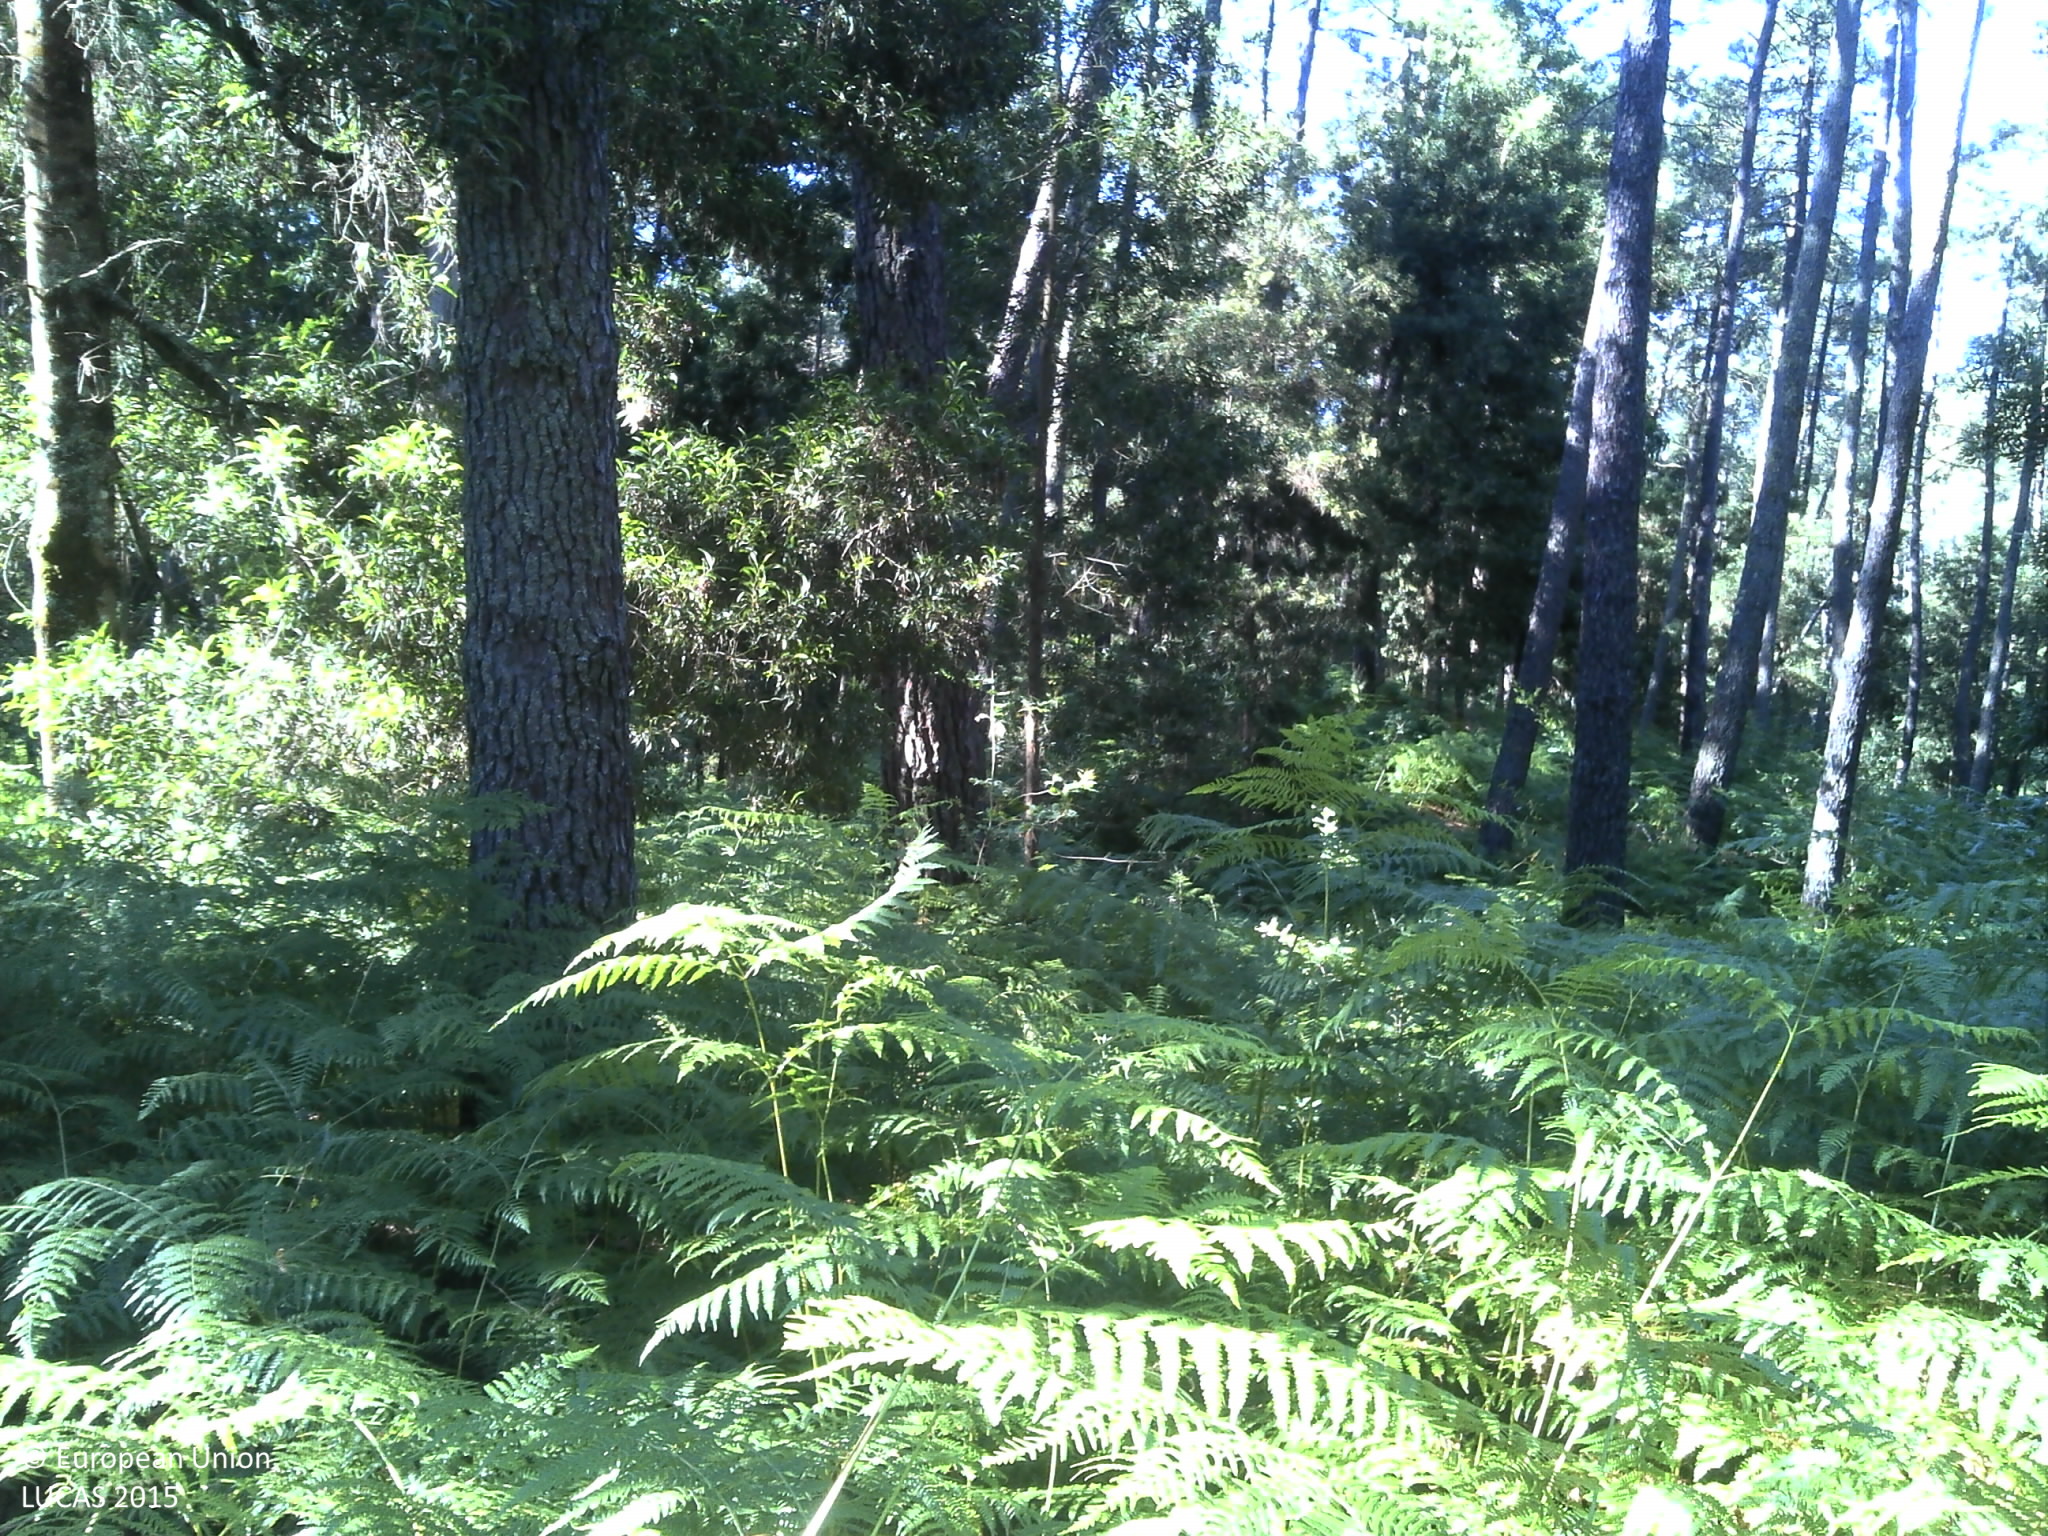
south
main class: Woodland
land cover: Pine dominated coniferous woodland
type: coniferous forest of the mediterranean region
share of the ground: 50 - 75 %
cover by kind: coniferous forest trees 60 %, shrubs 25 %, unconsolidated bare surface 10 %, herbaceous plants 5 %
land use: Forestry
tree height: > 5 m
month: June
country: PT
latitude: 40.6828
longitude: -7.9567
